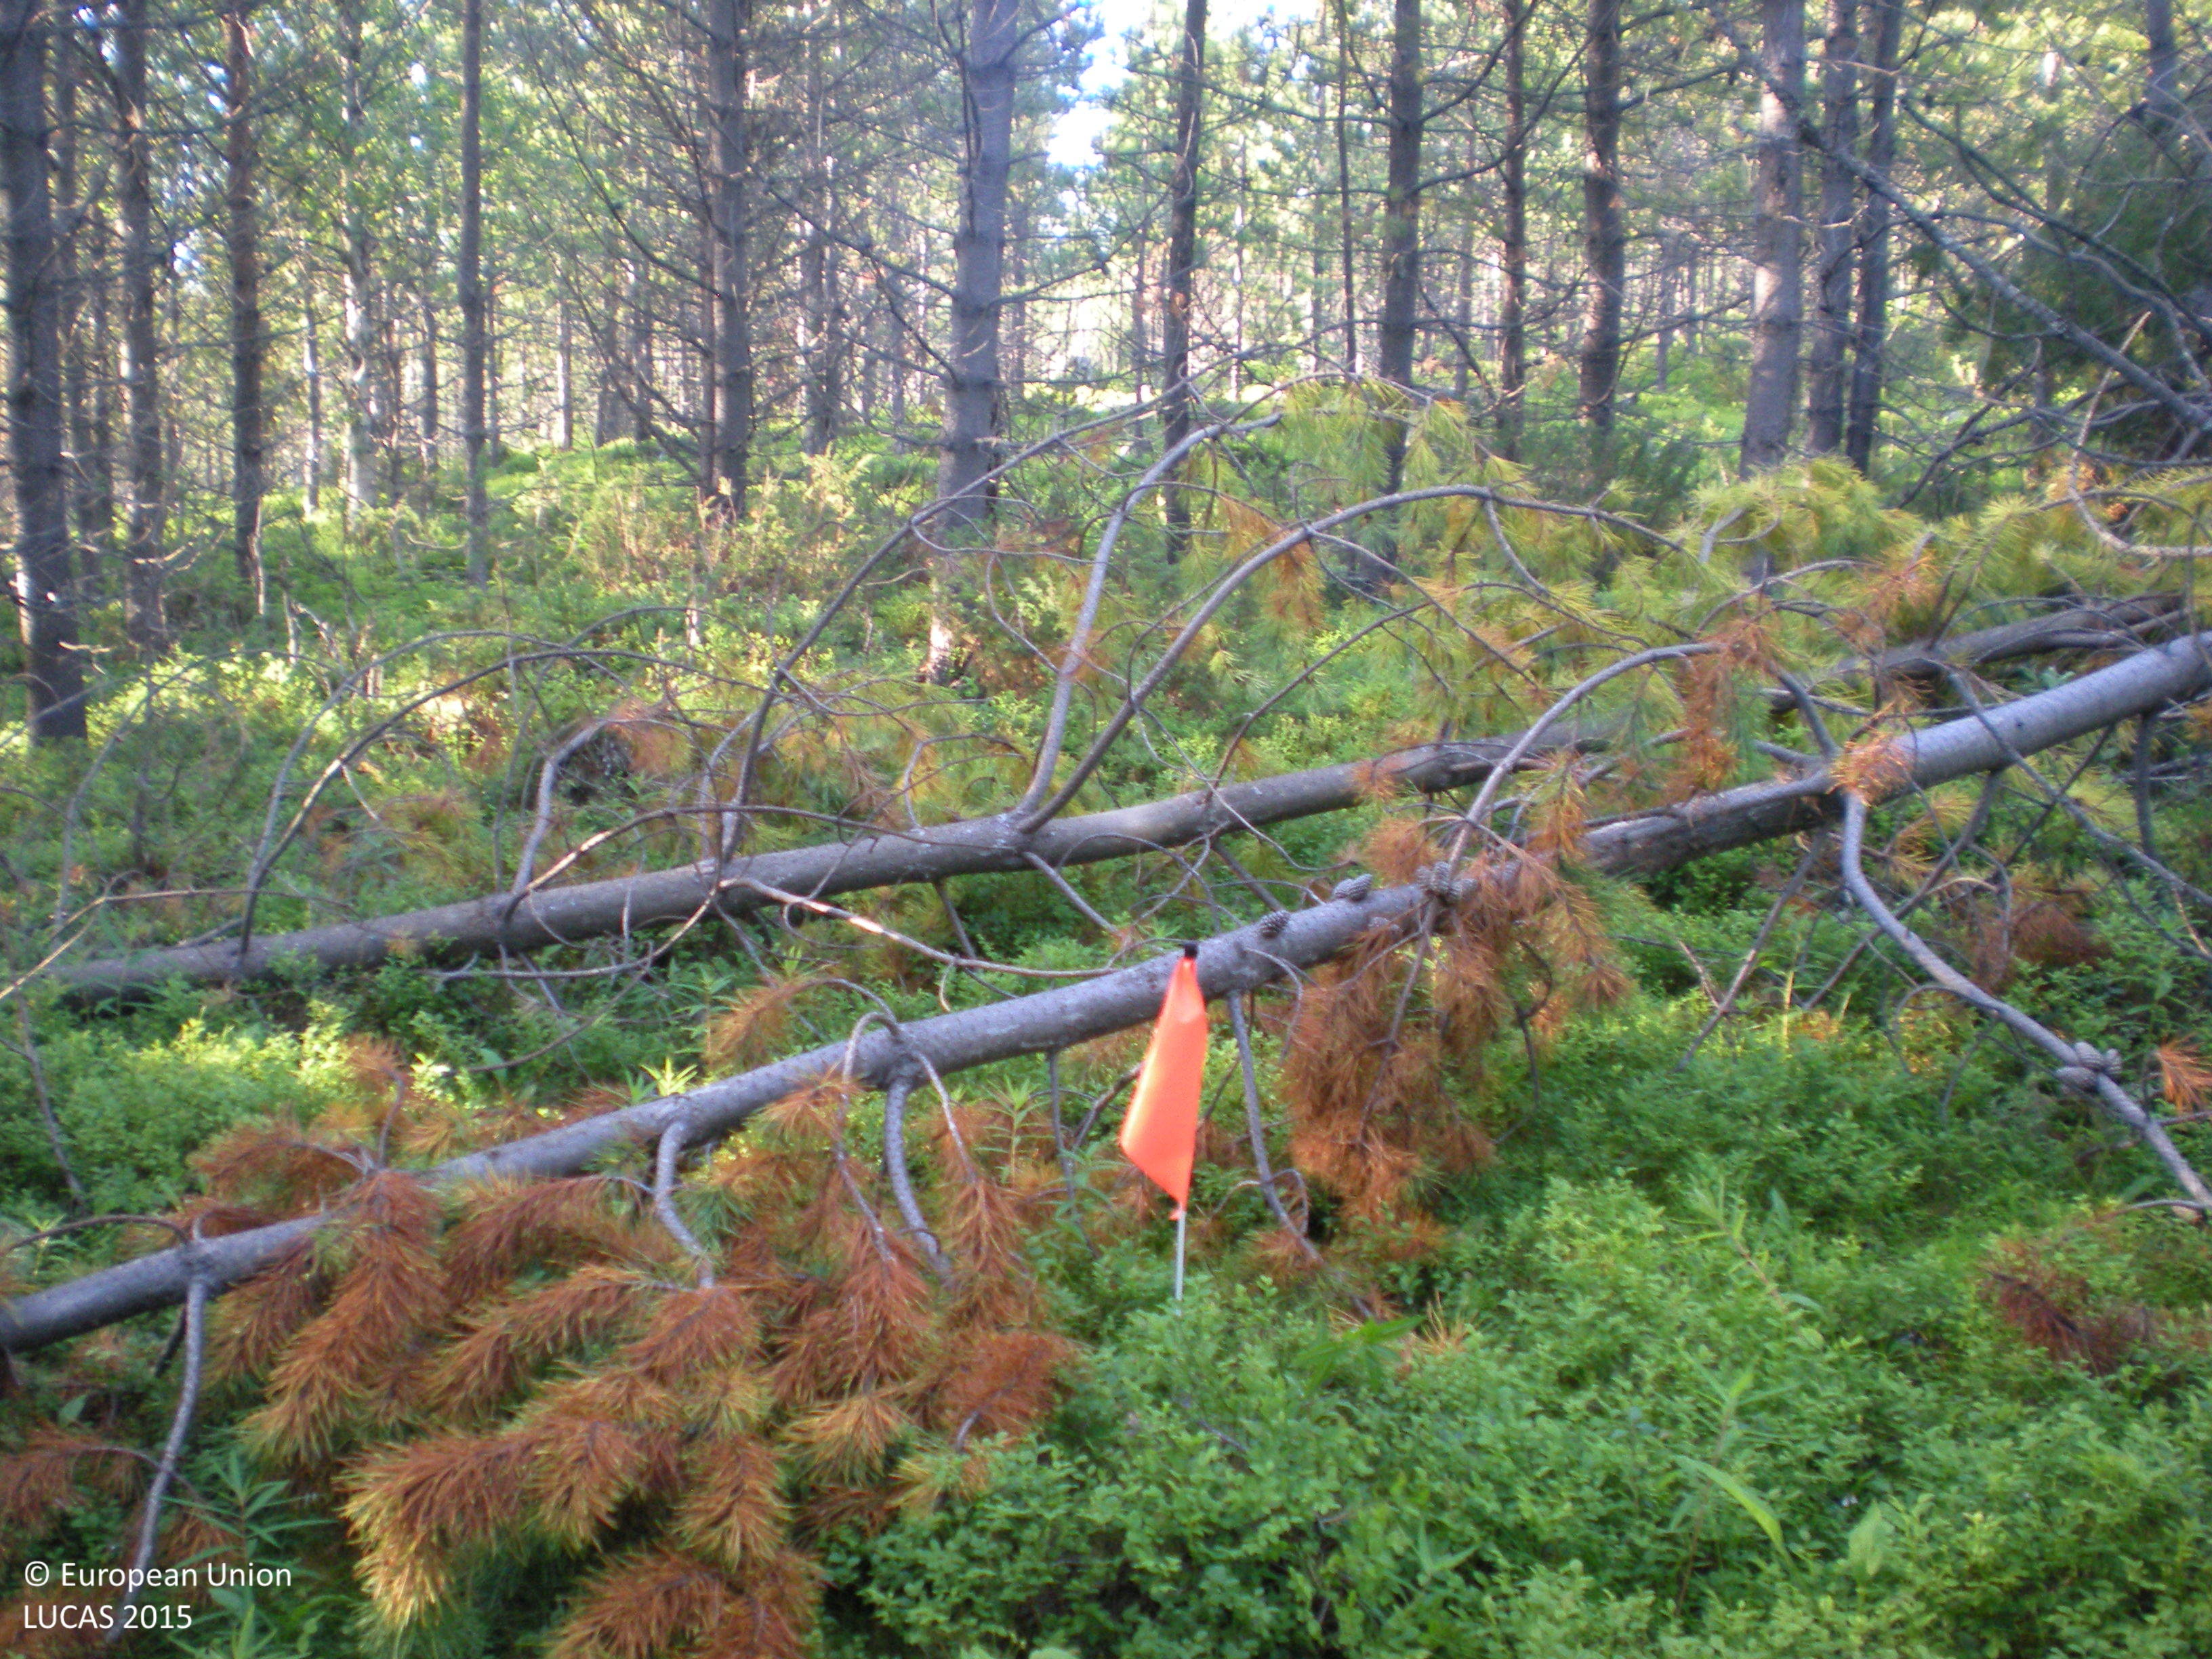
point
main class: Woodland
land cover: Pine dominated coniferous woodland
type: exotic forest
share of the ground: 50 - 75 %
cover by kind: coniferous forest trees 75 %, shrubs 20 %, consolidated bare surface 5 %
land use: Forestry
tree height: > 5 m
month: August
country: SE
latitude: 66.2672
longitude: 18.0360
